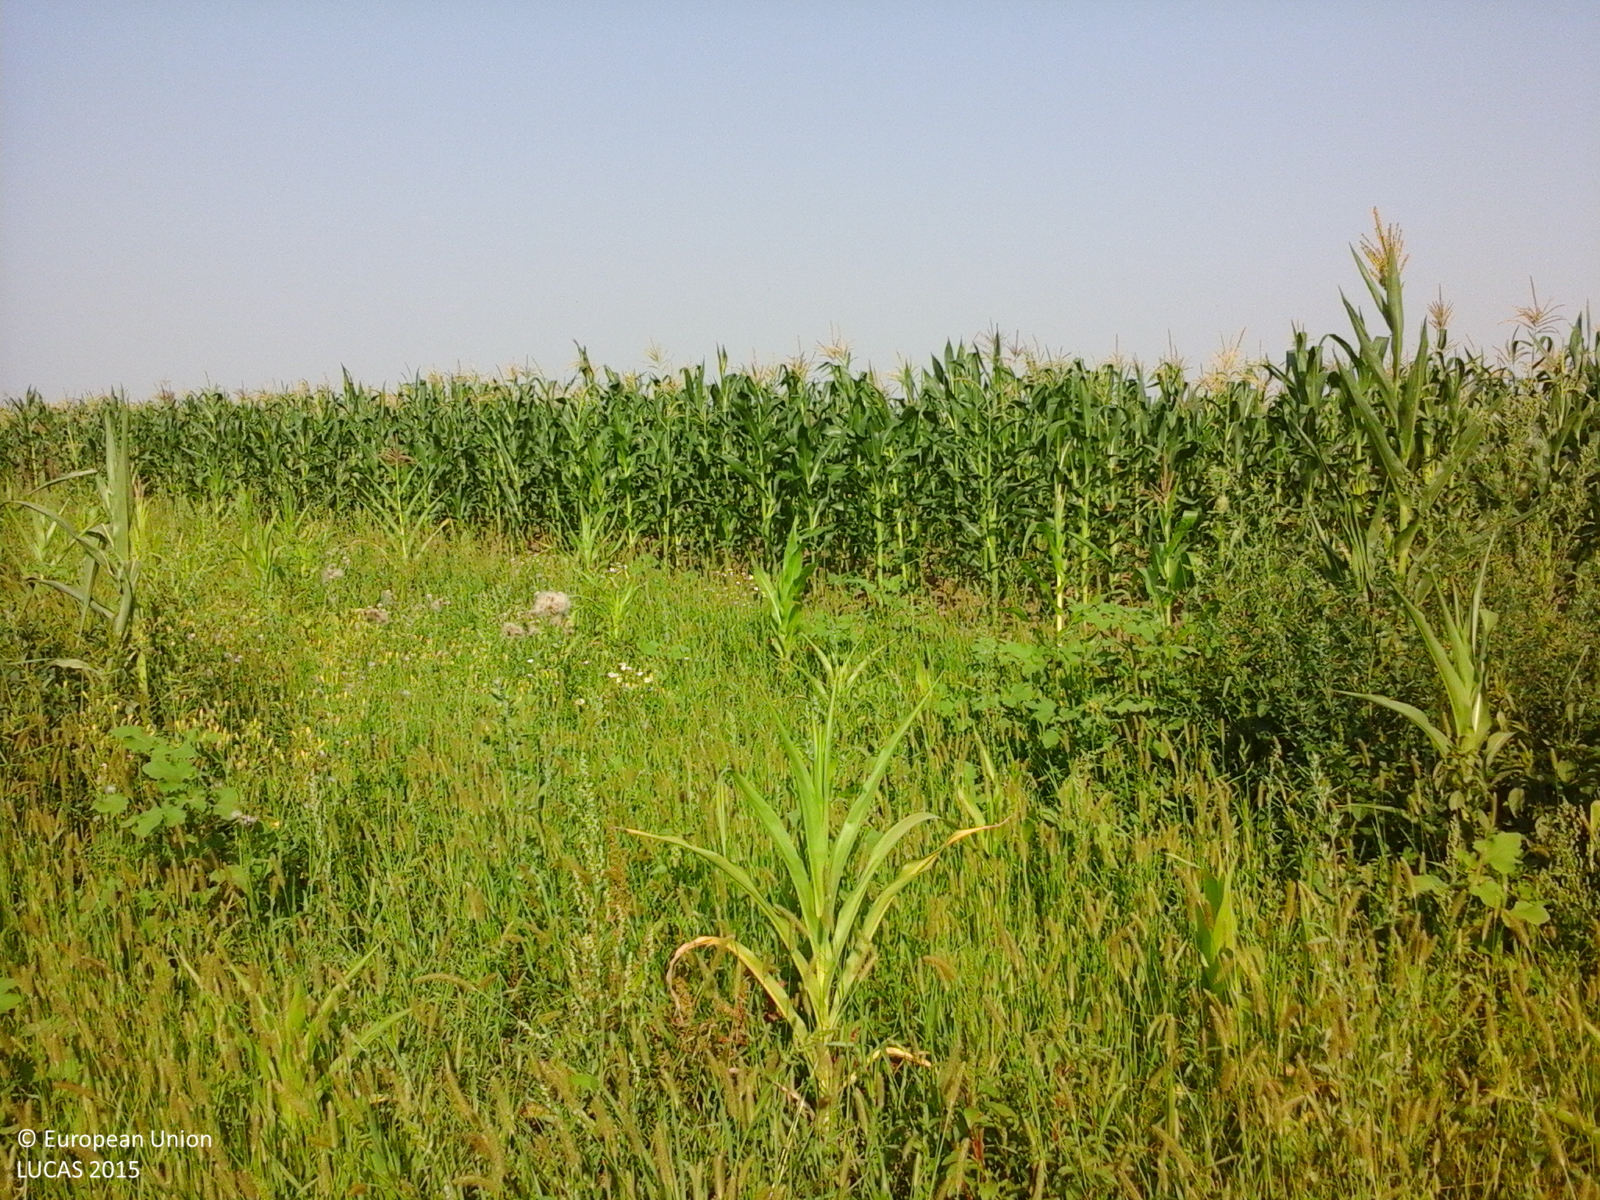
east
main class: Grassland
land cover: Grassland without tree/shrub cover
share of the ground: > 75 %
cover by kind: herbaceous plants 100 %
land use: Agriculture (excluding fallow land and kitchen gardens)
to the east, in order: Spontaneously vegetated surfaces; Maize; Oats; Spontaneously vegetated surfaces; Oats; Spontaneously vegetated surfaces; Maize; Tracks; Other leguminous and mixtures for fodder; Other bare soil
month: July
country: RO
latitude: 44.5768
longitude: 25.3397
